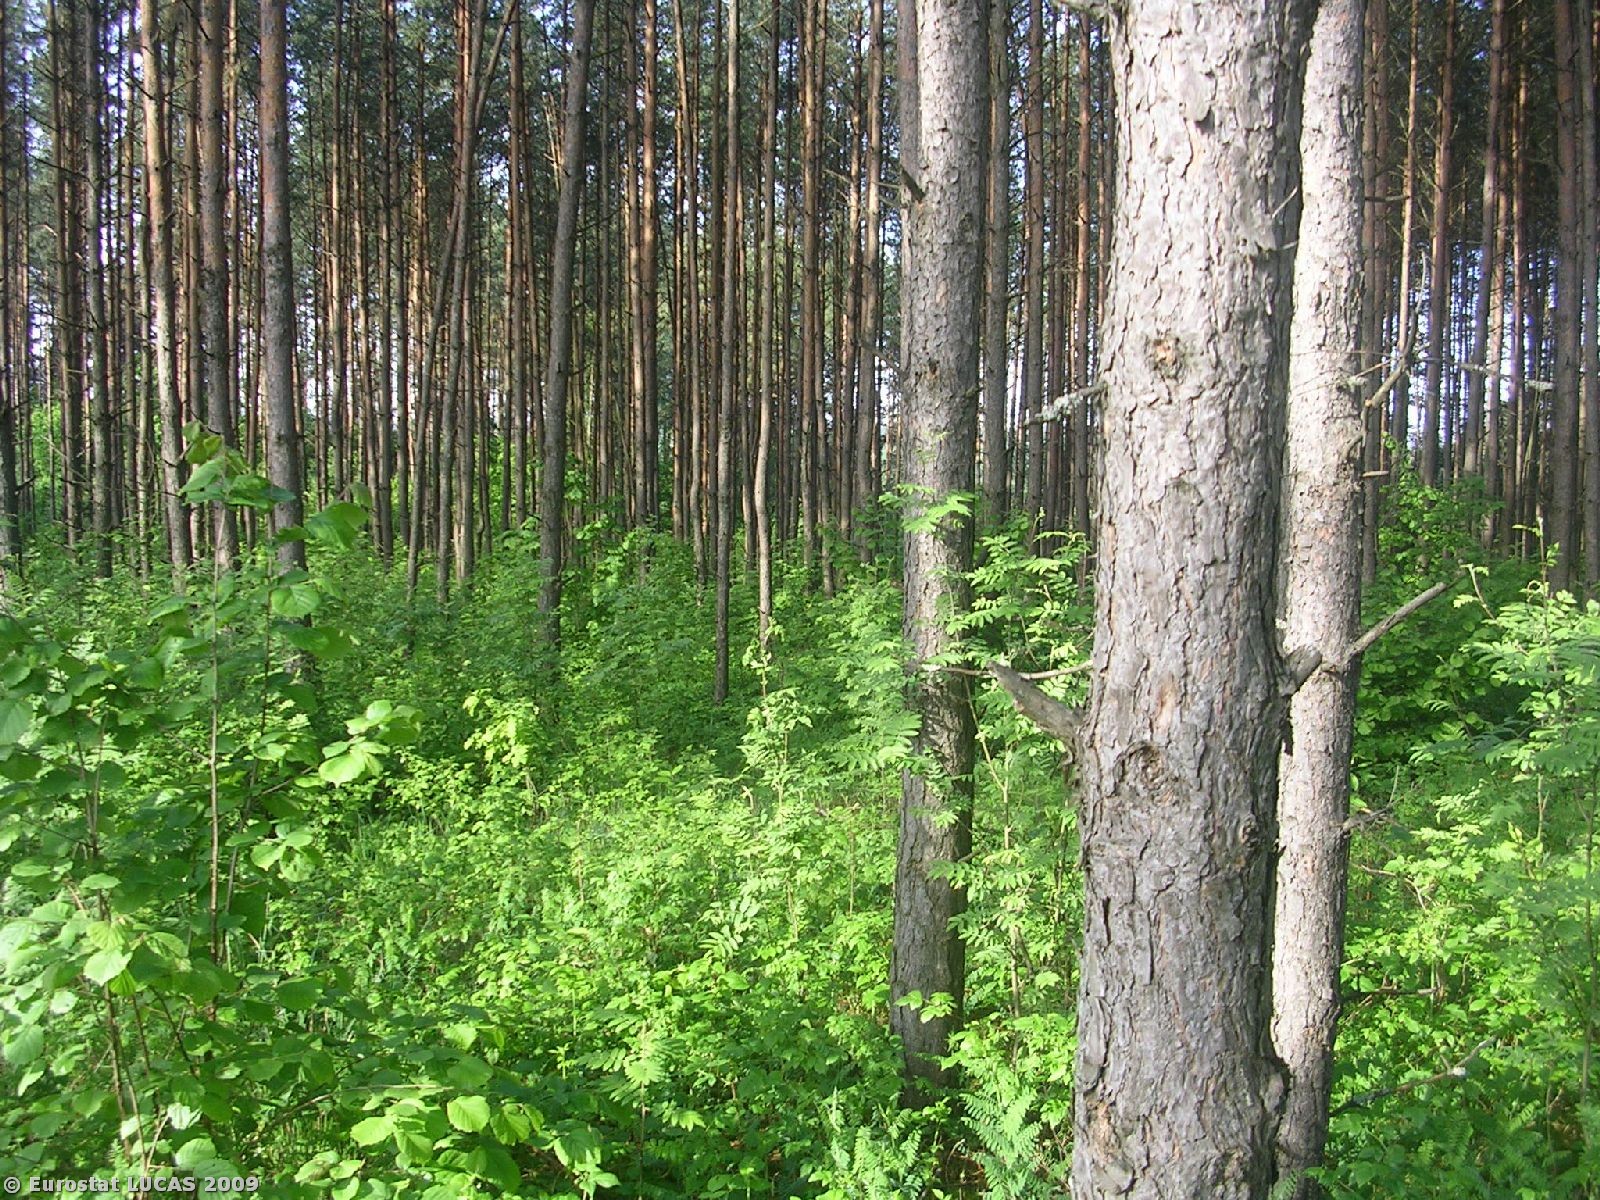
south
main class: Woodland
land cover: Mixed woodland
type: hemiboreal forest and nemoral coniferous forest and mixed broadleaved-coniferous forest
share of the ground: 25 - 50 %
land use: Forestry
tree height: > 5 m
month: May
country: PL
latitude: 53.2350
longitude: 23.2483
